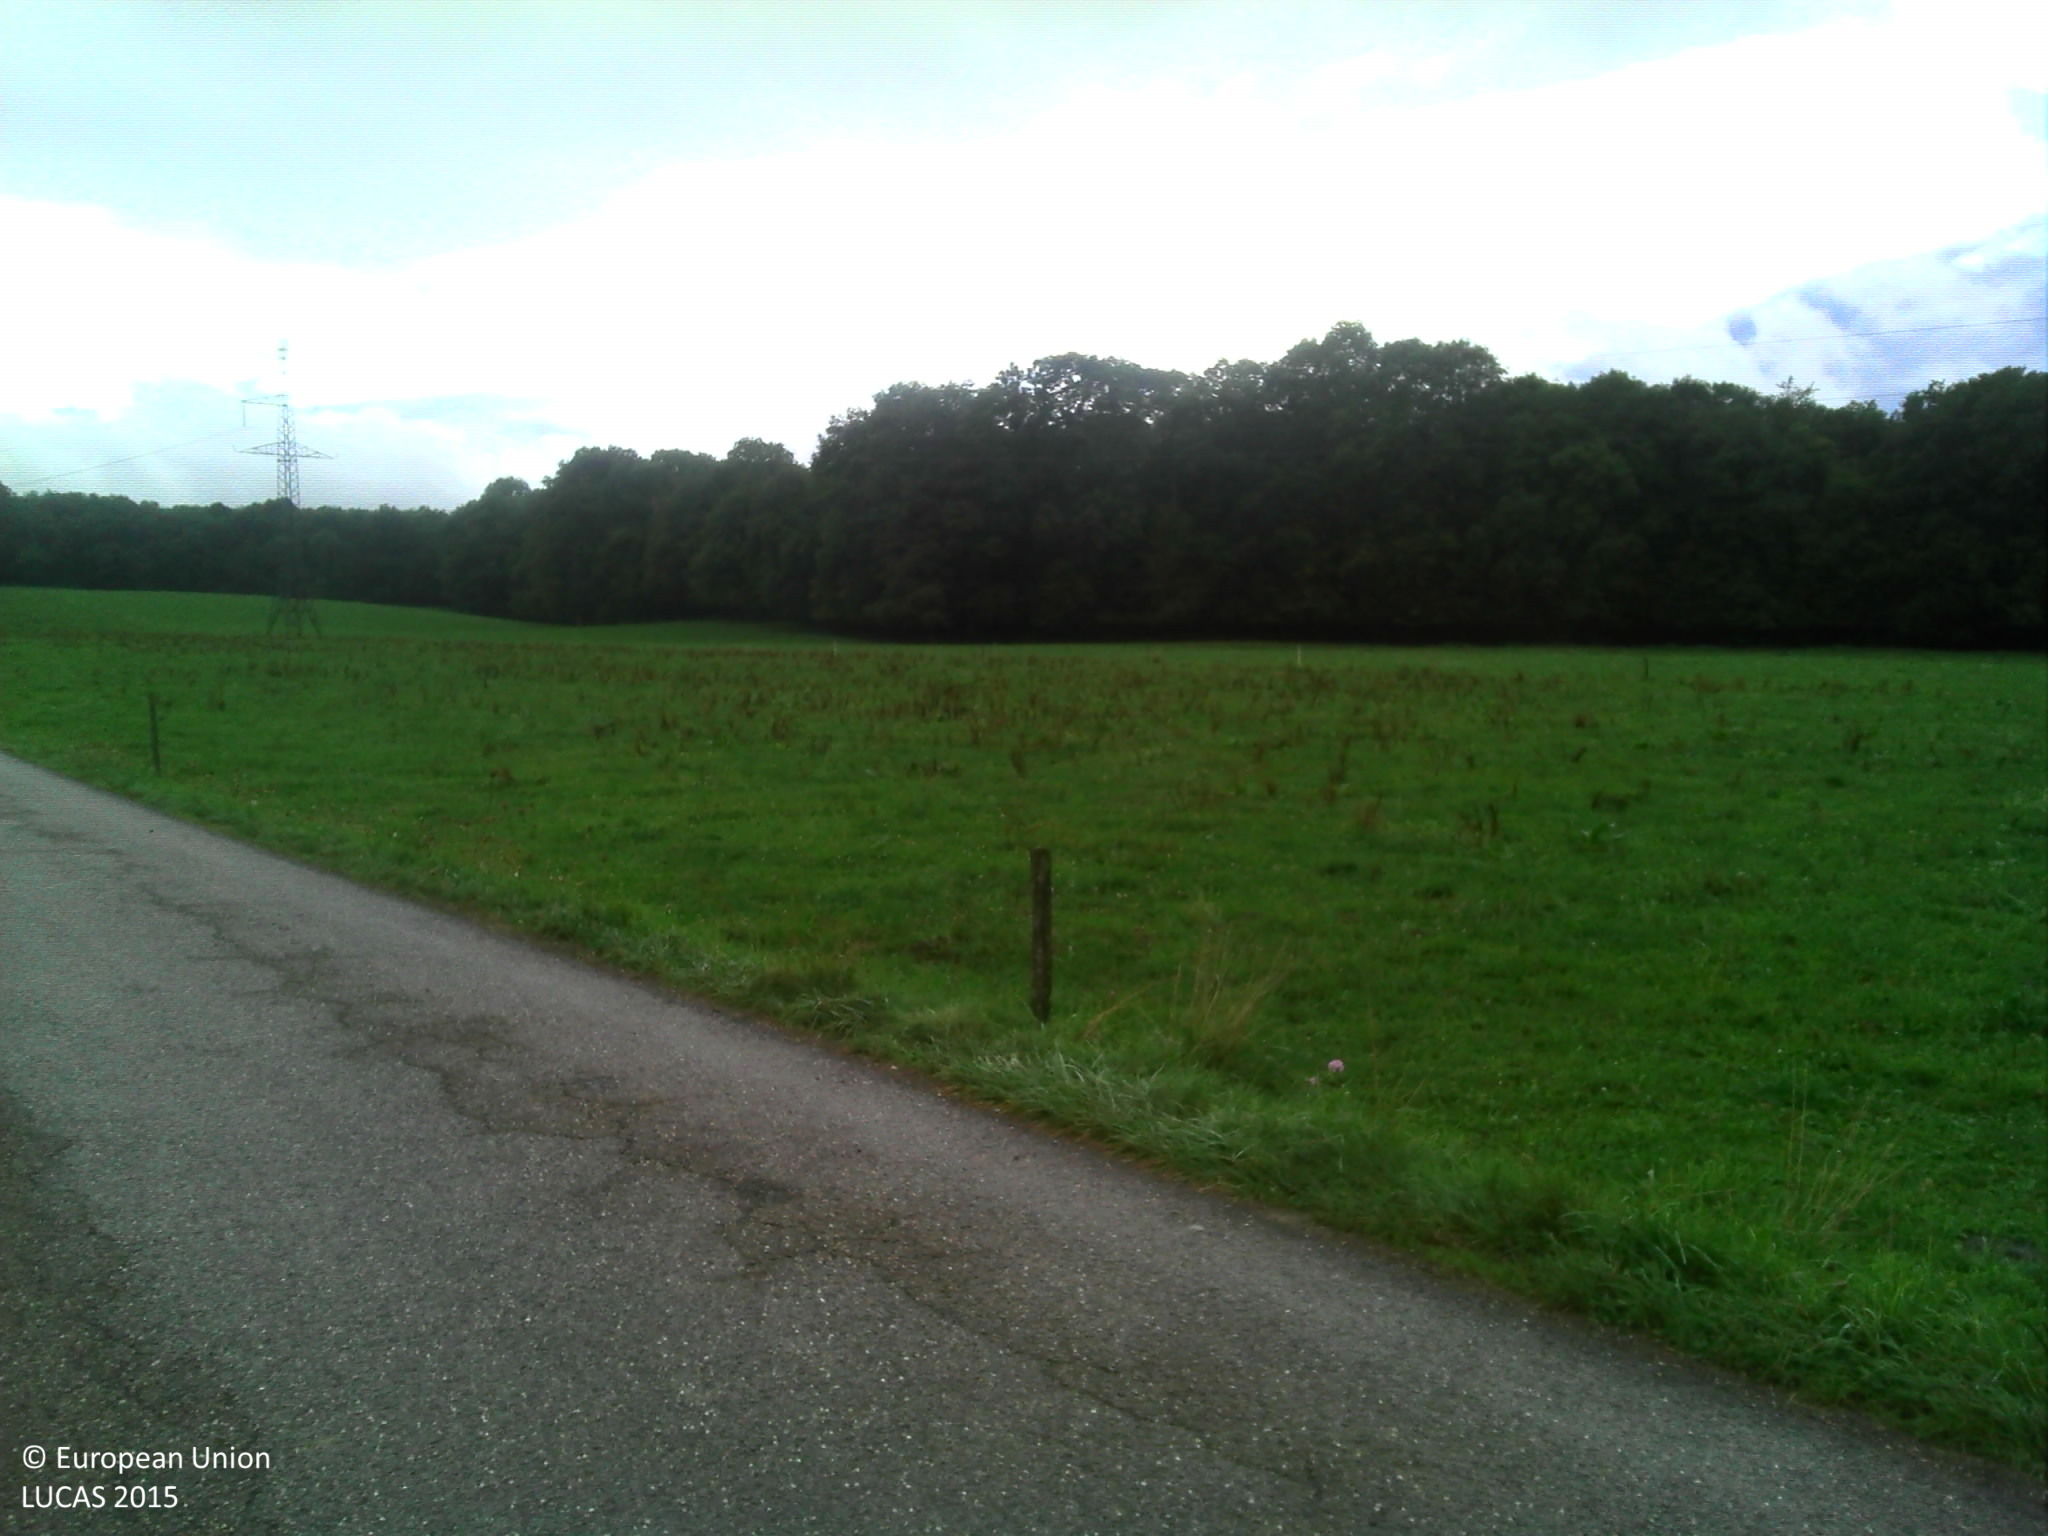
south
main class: Grassland
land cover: Grassland without tree/shrub cover
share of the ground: > 75 %
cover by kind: herbaceous plants 80 %, unconsolidated bare surface 20 %
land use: Agriculture (excluding fallow land and kitchen gardens)
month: September
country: FR
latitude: 47.1818
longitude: 6.1091
